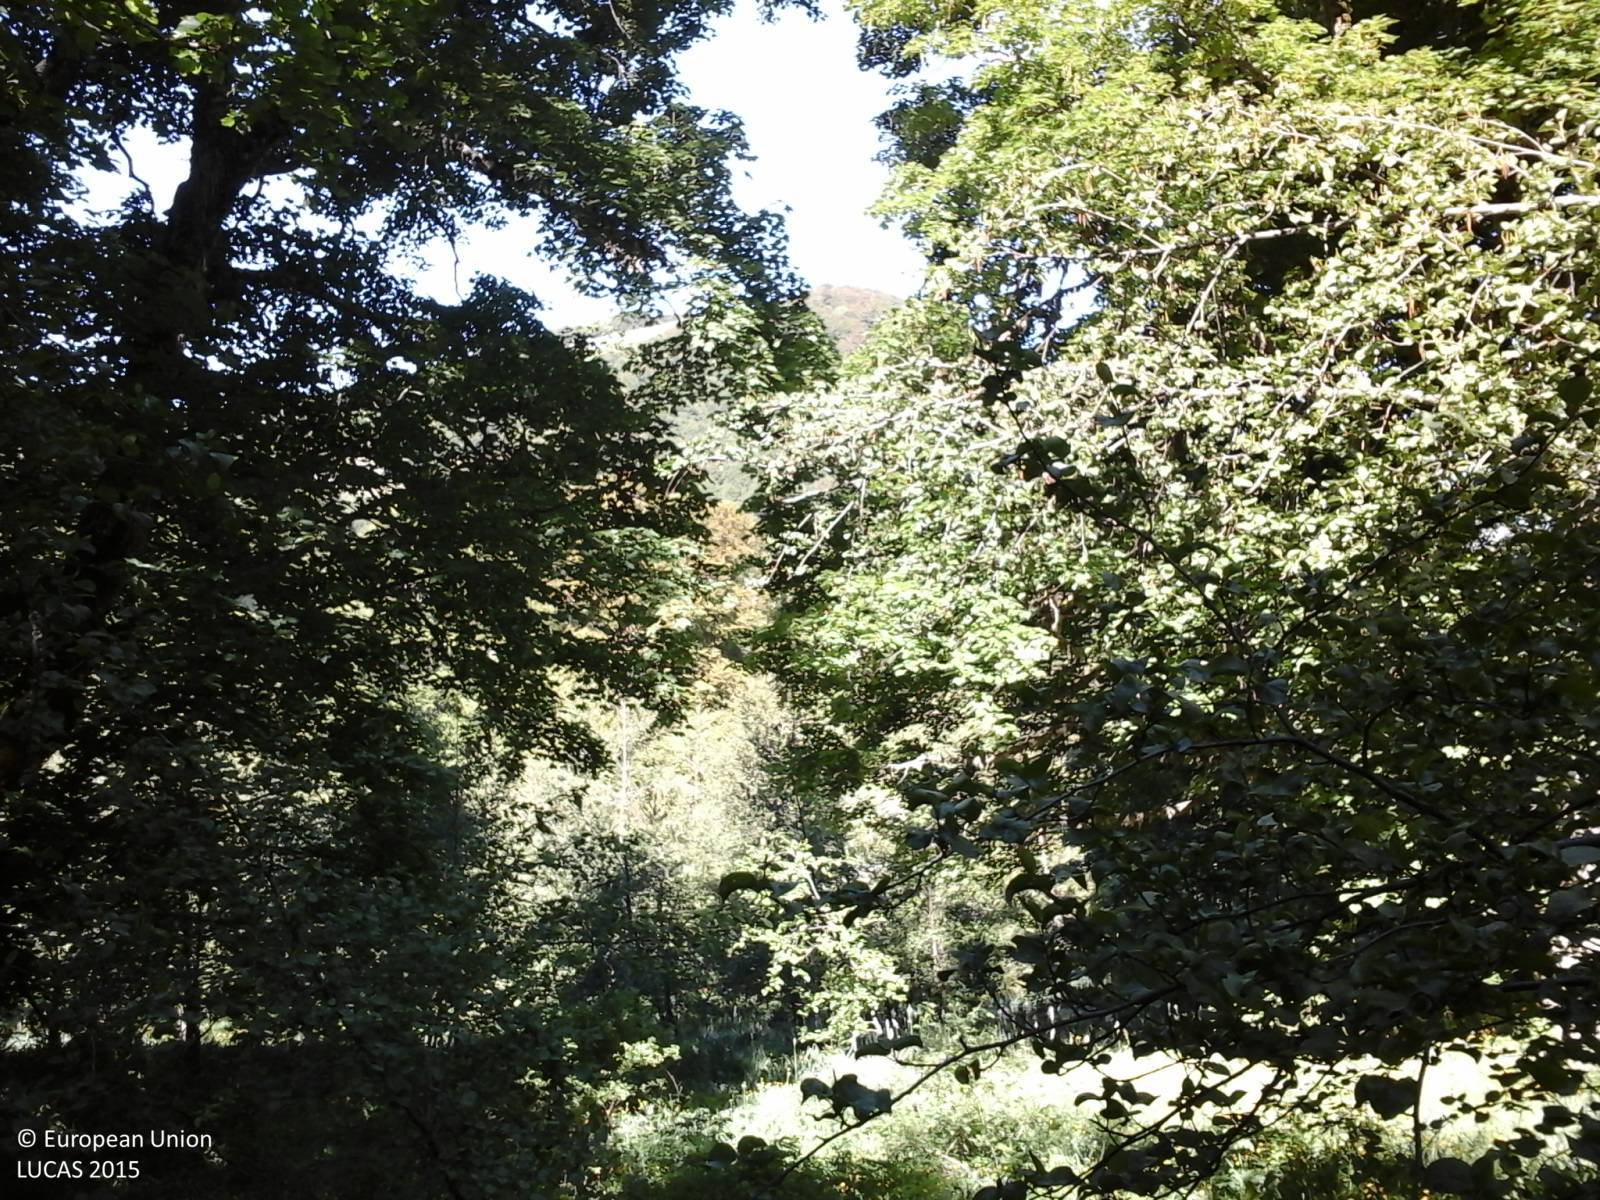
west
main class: Woodland
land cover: Broadleaved woodland
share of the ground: > 75 %
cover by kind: broadleaved forest trees 80 %, herbaceous plants 15 %, shrubs 5 %
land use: Semi-natural and natural areas not in use
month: May
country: IT
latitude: 42.0065
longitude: 13.2125
